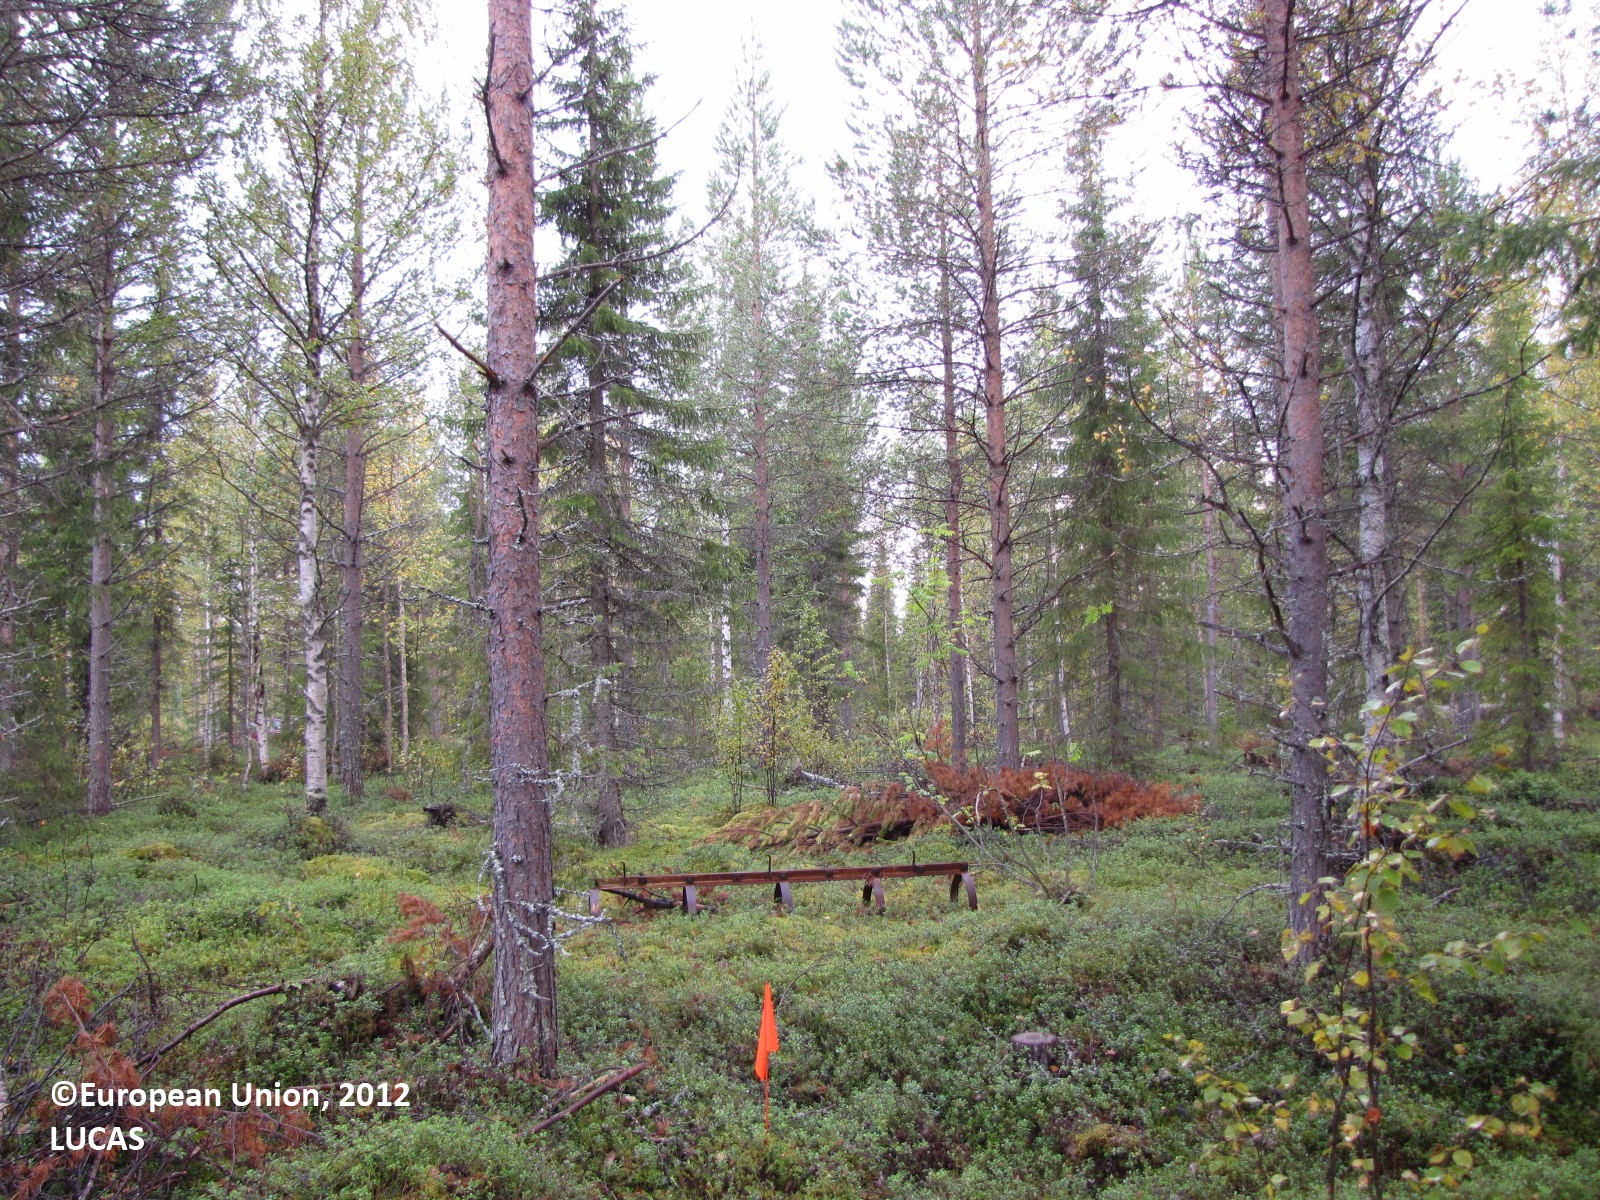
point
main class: Woodland
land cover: Other mixed woodland
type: boreal forest
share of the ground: 10 - 25 %
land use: Forestry
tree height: > 5 m
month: September
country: FI
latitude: 67.2689
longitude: 23.8692
